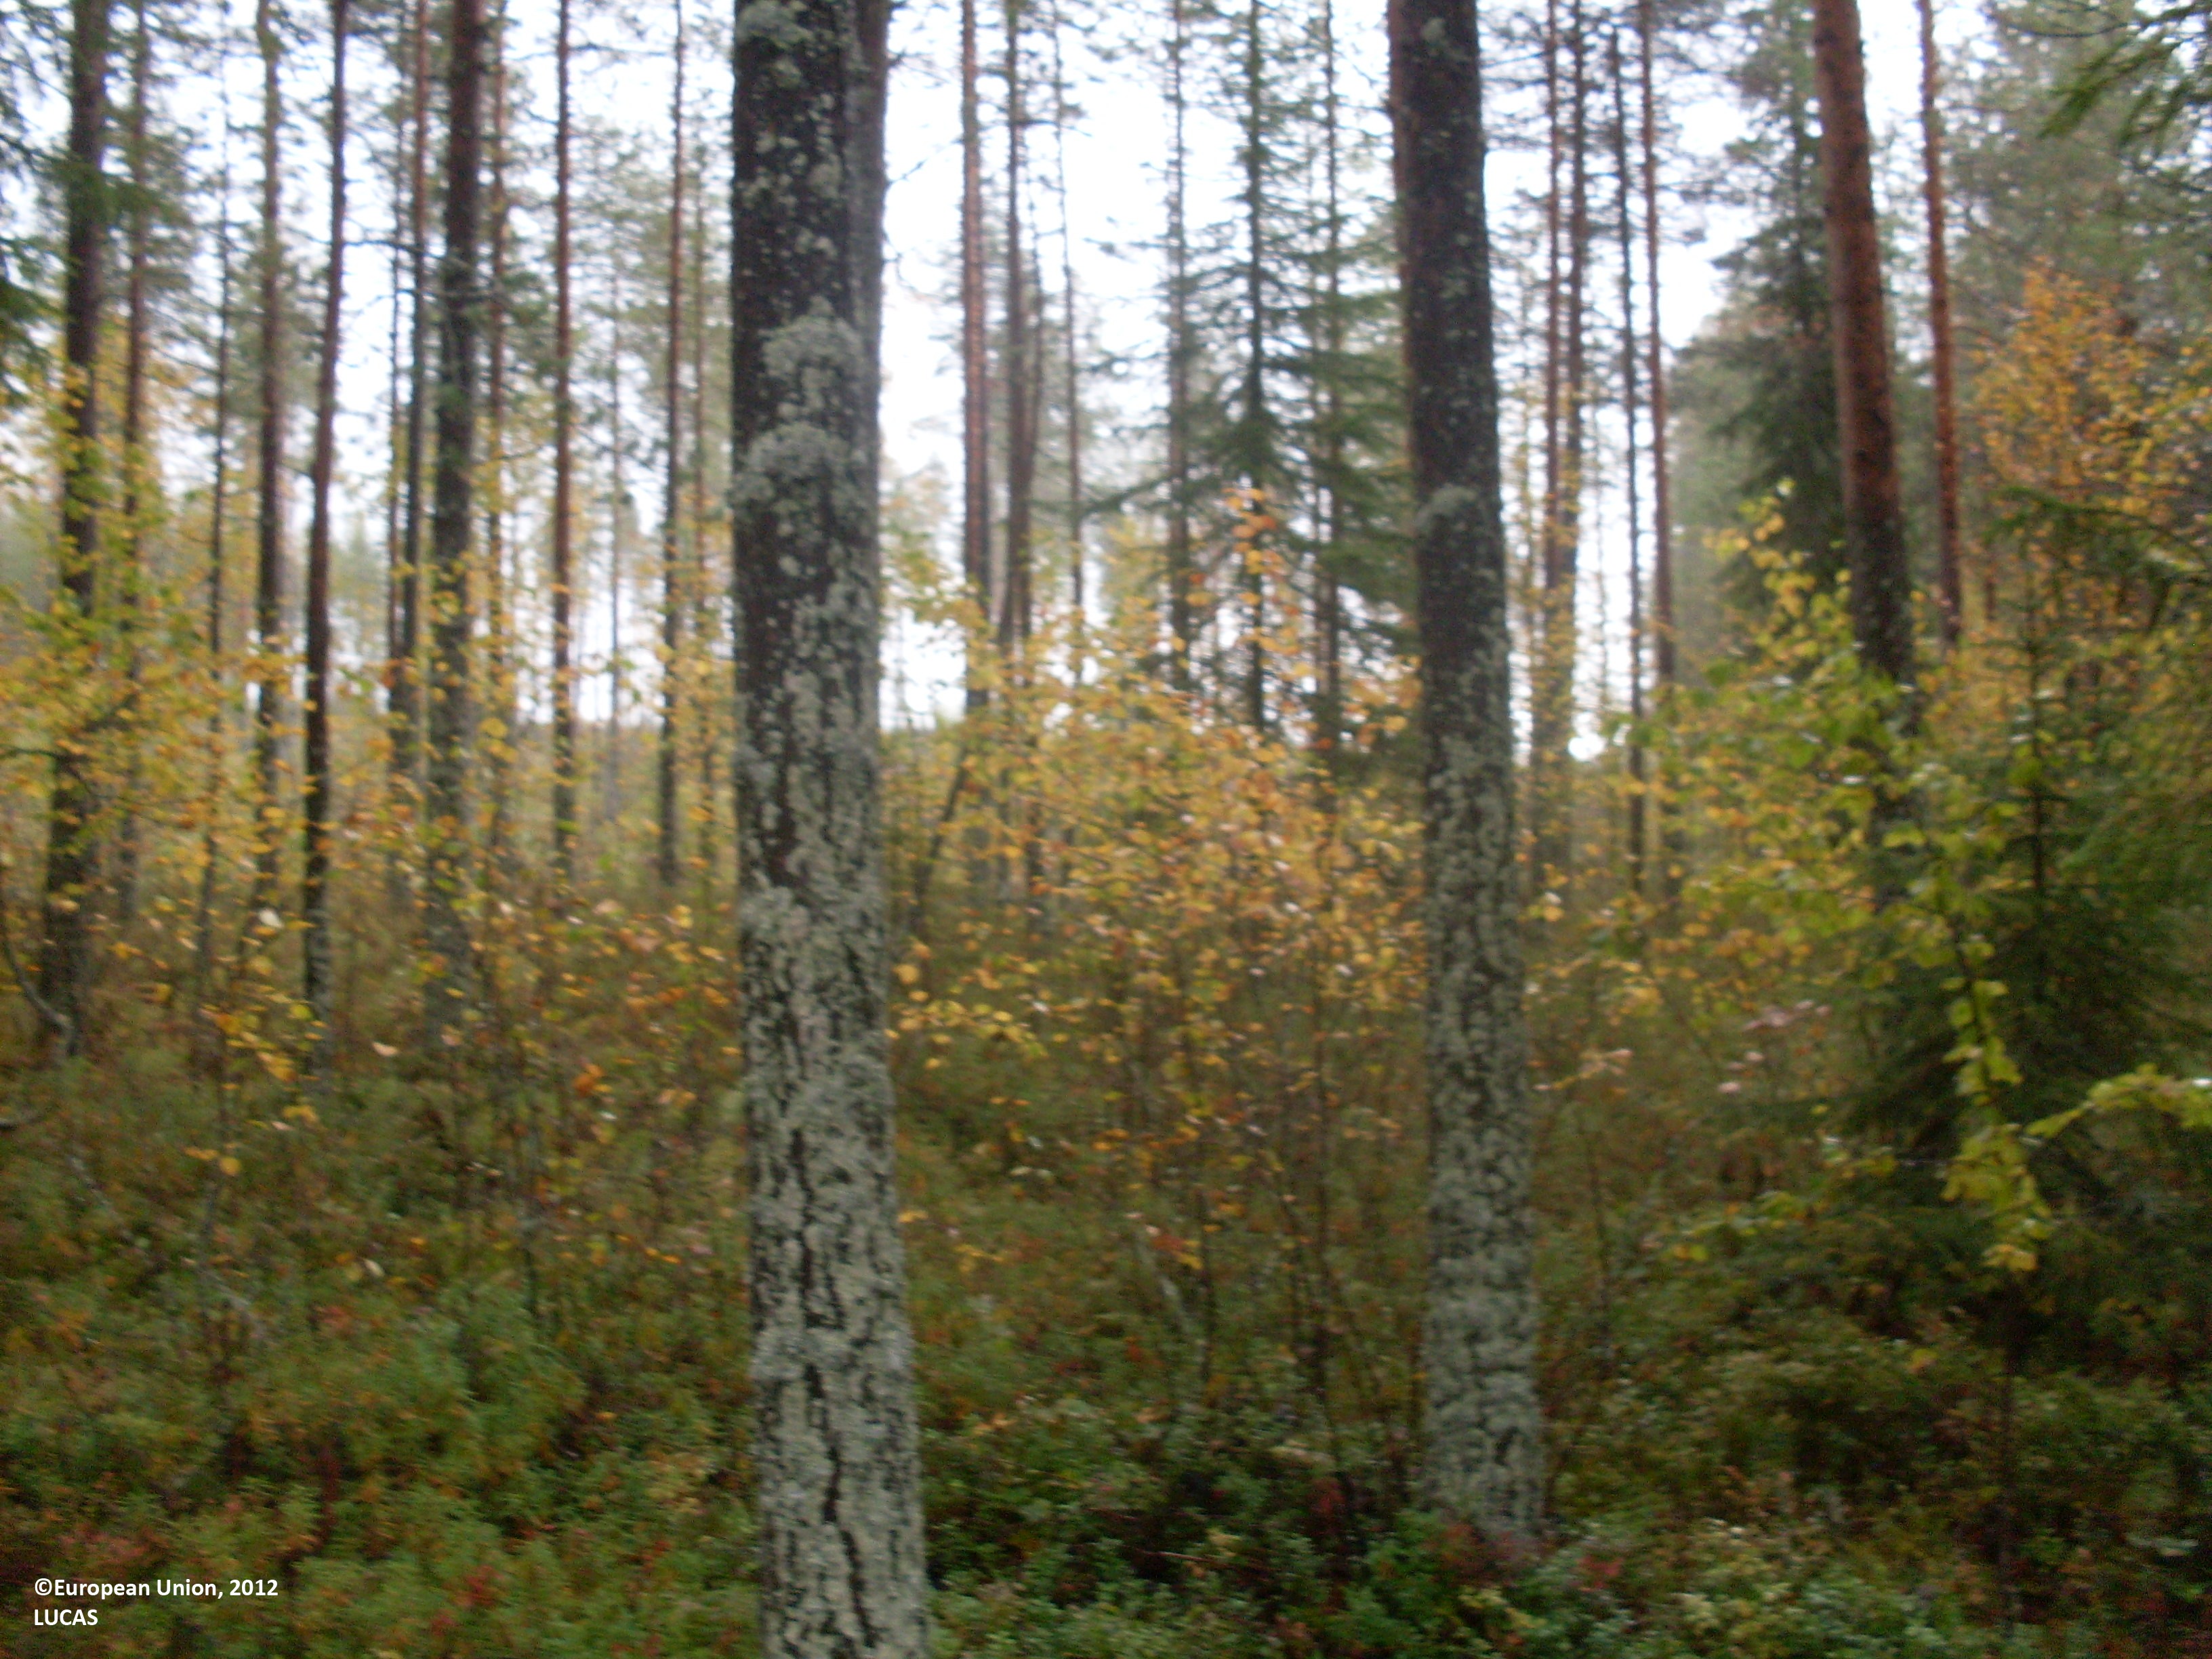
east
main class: Woodland
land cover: Pine dominated mixed woodland
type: boreal forest
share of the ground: > 75 %
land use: Forestry
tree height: > 5 m
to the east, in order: Pine dominated mixed woodland; Spruce dominated coniferous woodland; Ditches and canals; Spruce dominated coniferous woodland
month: September
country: FI
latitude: 64.0150
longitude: 30.1946
